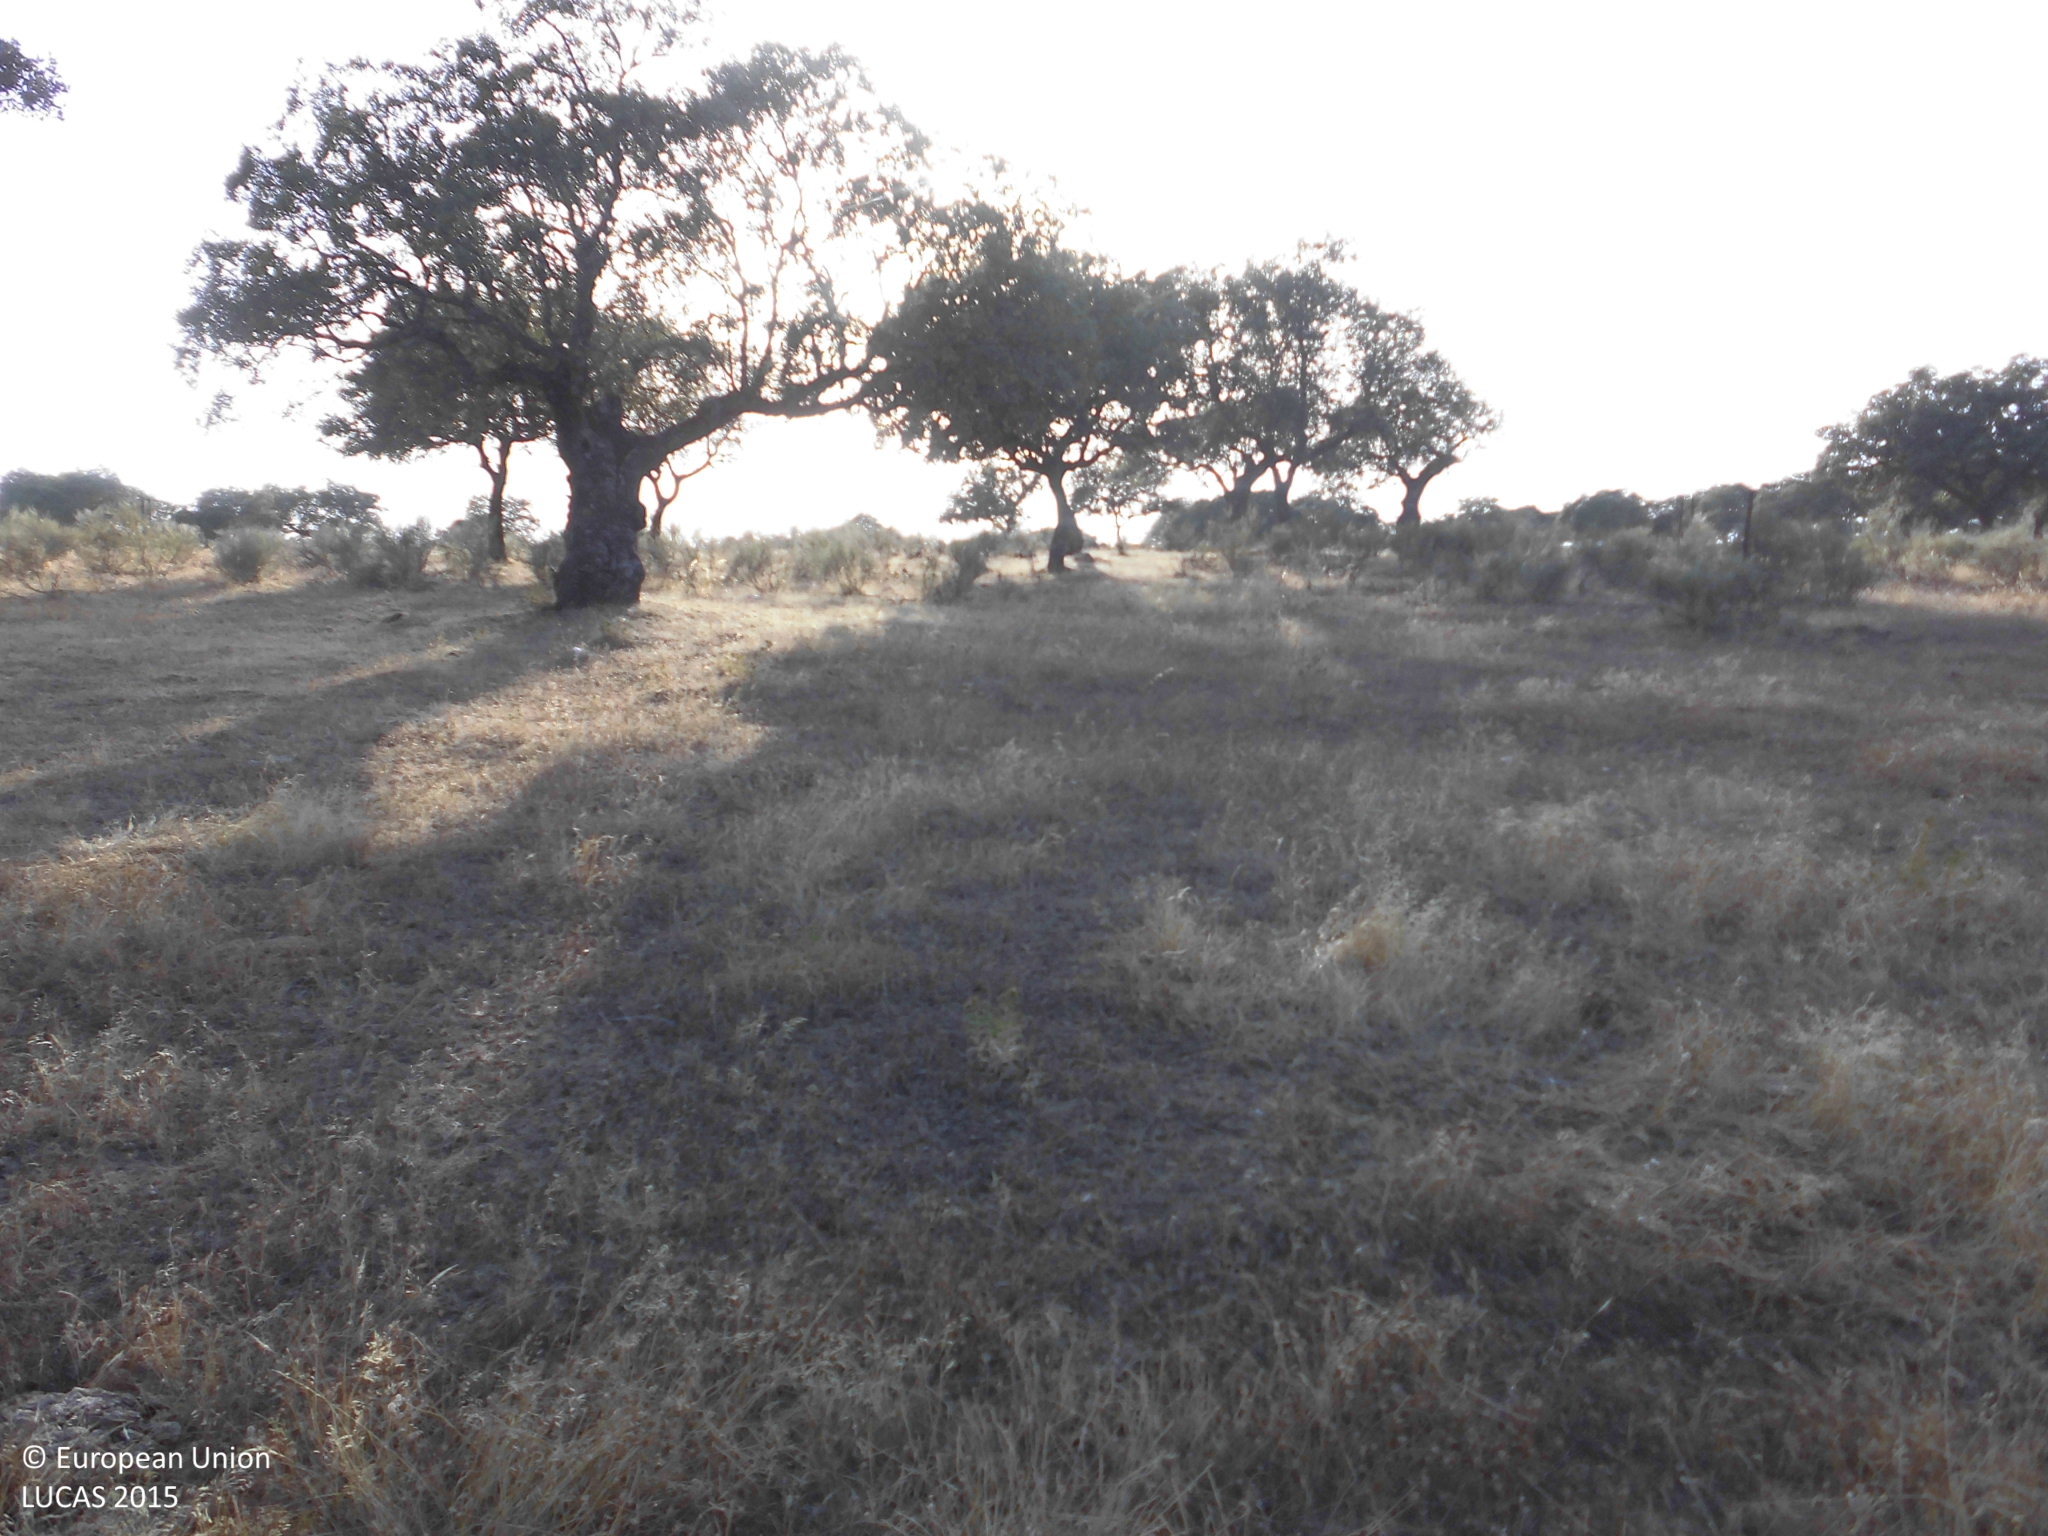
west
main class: Woodland
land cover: Broadleaved woodland
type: broadleaved evergreen forest
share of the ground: 10 - 25 %
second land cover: Grassland without tree/shrub cover
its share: > 75 %
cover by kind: herbaceous plants 90 %, broadleaved forest trees 10 %
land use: Forestry
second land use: Agriculture (excluding fallow land and kitchen gardens)
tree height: > 5 m
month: July
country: ES
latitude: 39.6269
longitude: -5.6563
